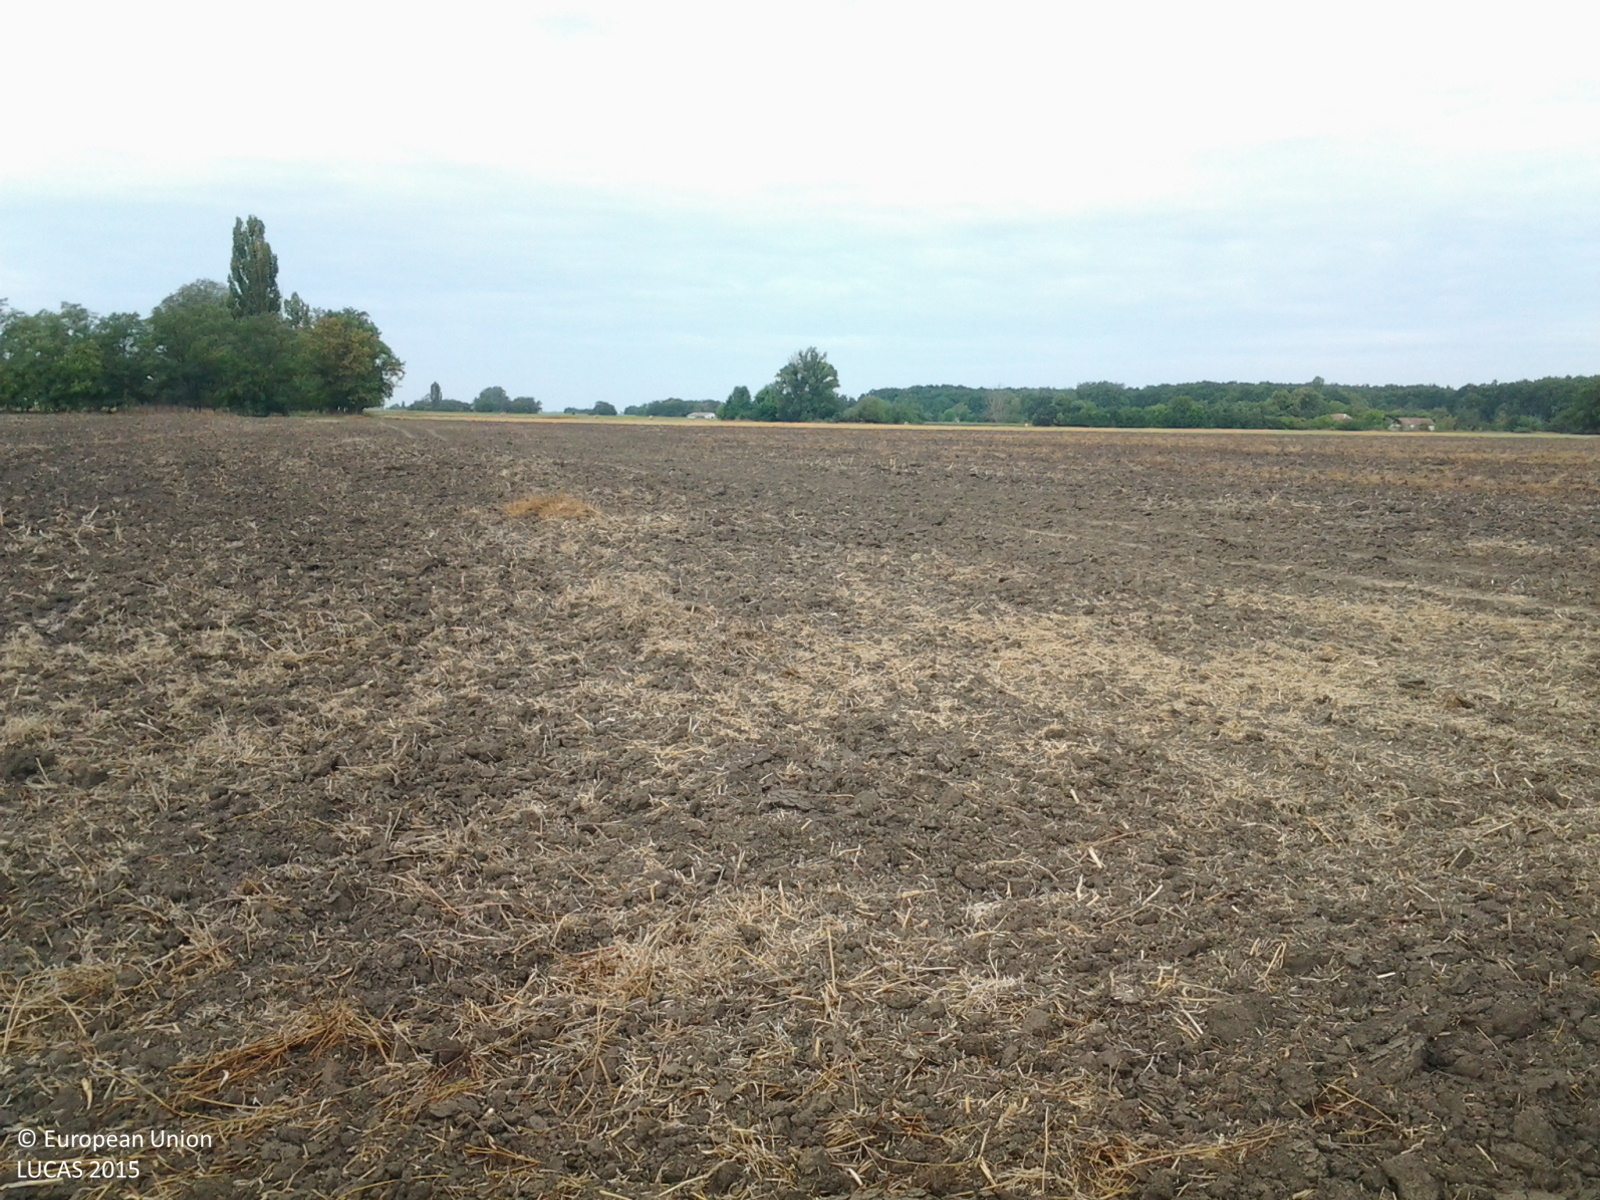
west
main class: Cropland
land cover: Rape and turnip rape
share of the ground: < 10 %
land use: Agriculture (excluding fallow land and kitchen gardens)
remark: Harvested field
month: July
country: HU
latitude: 47.1770
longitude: 20.4929
